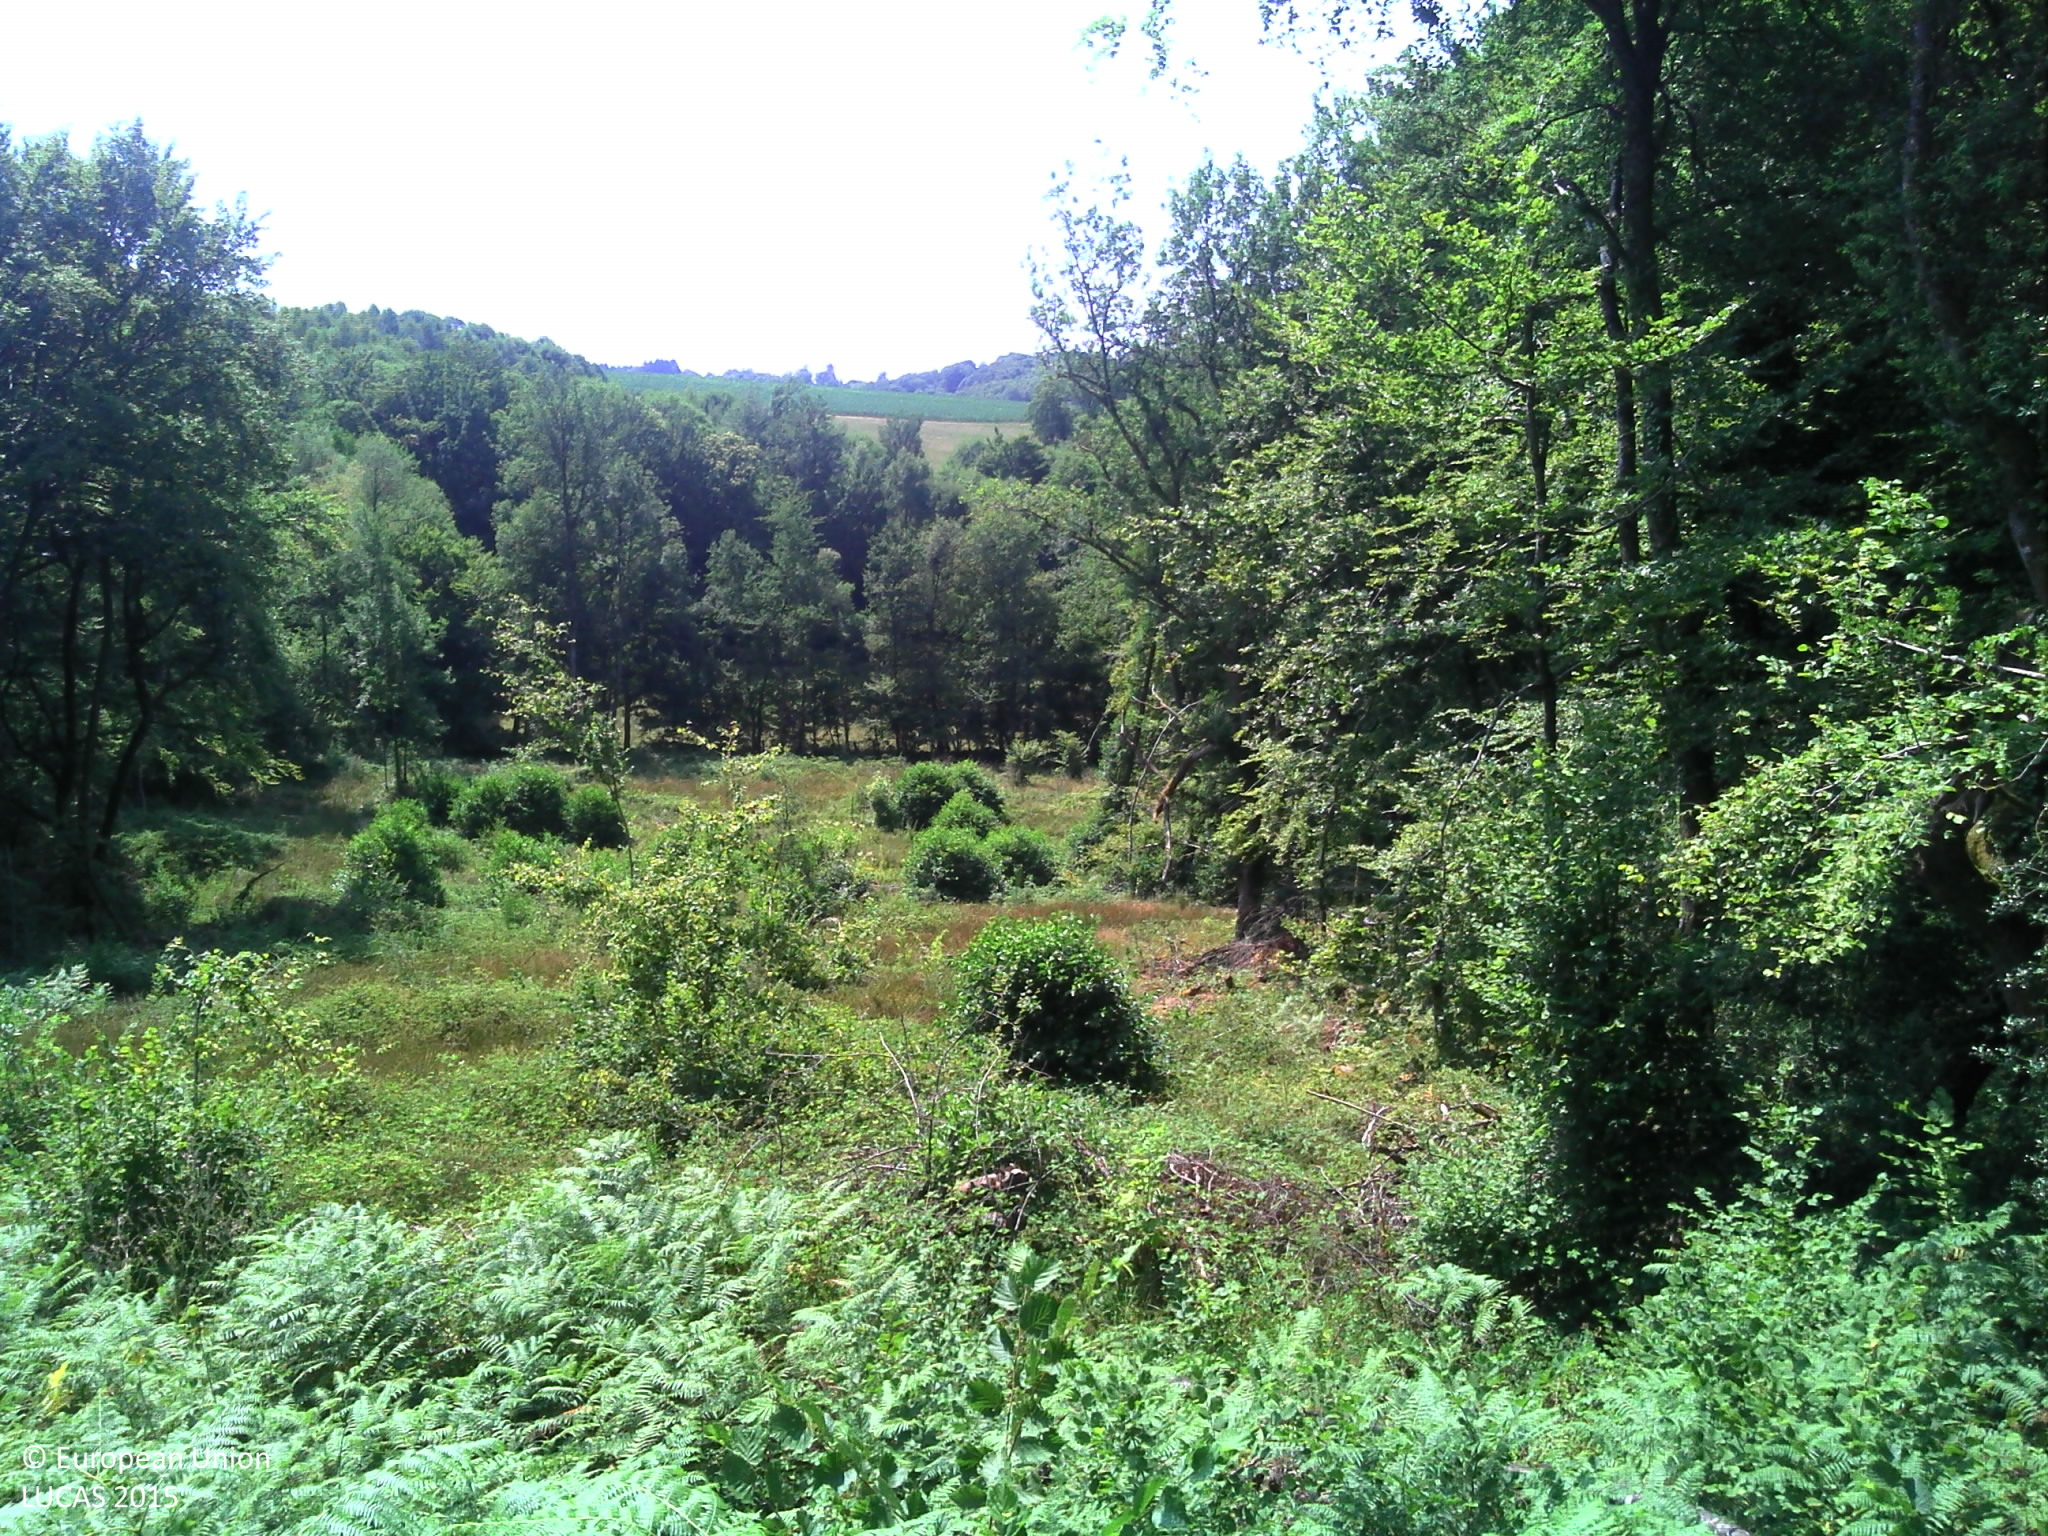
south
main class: Shrubland
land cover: Shrubland with sparse tree cover
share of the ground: > 75 %
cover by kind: shrubs 75 %, herbaceous plants 20 %, broadleaved forest trees 5 %
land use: Forestry
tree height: < 5 m
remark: Clear cut
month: July
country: FR
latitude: 46.0510
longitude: 1.7601
